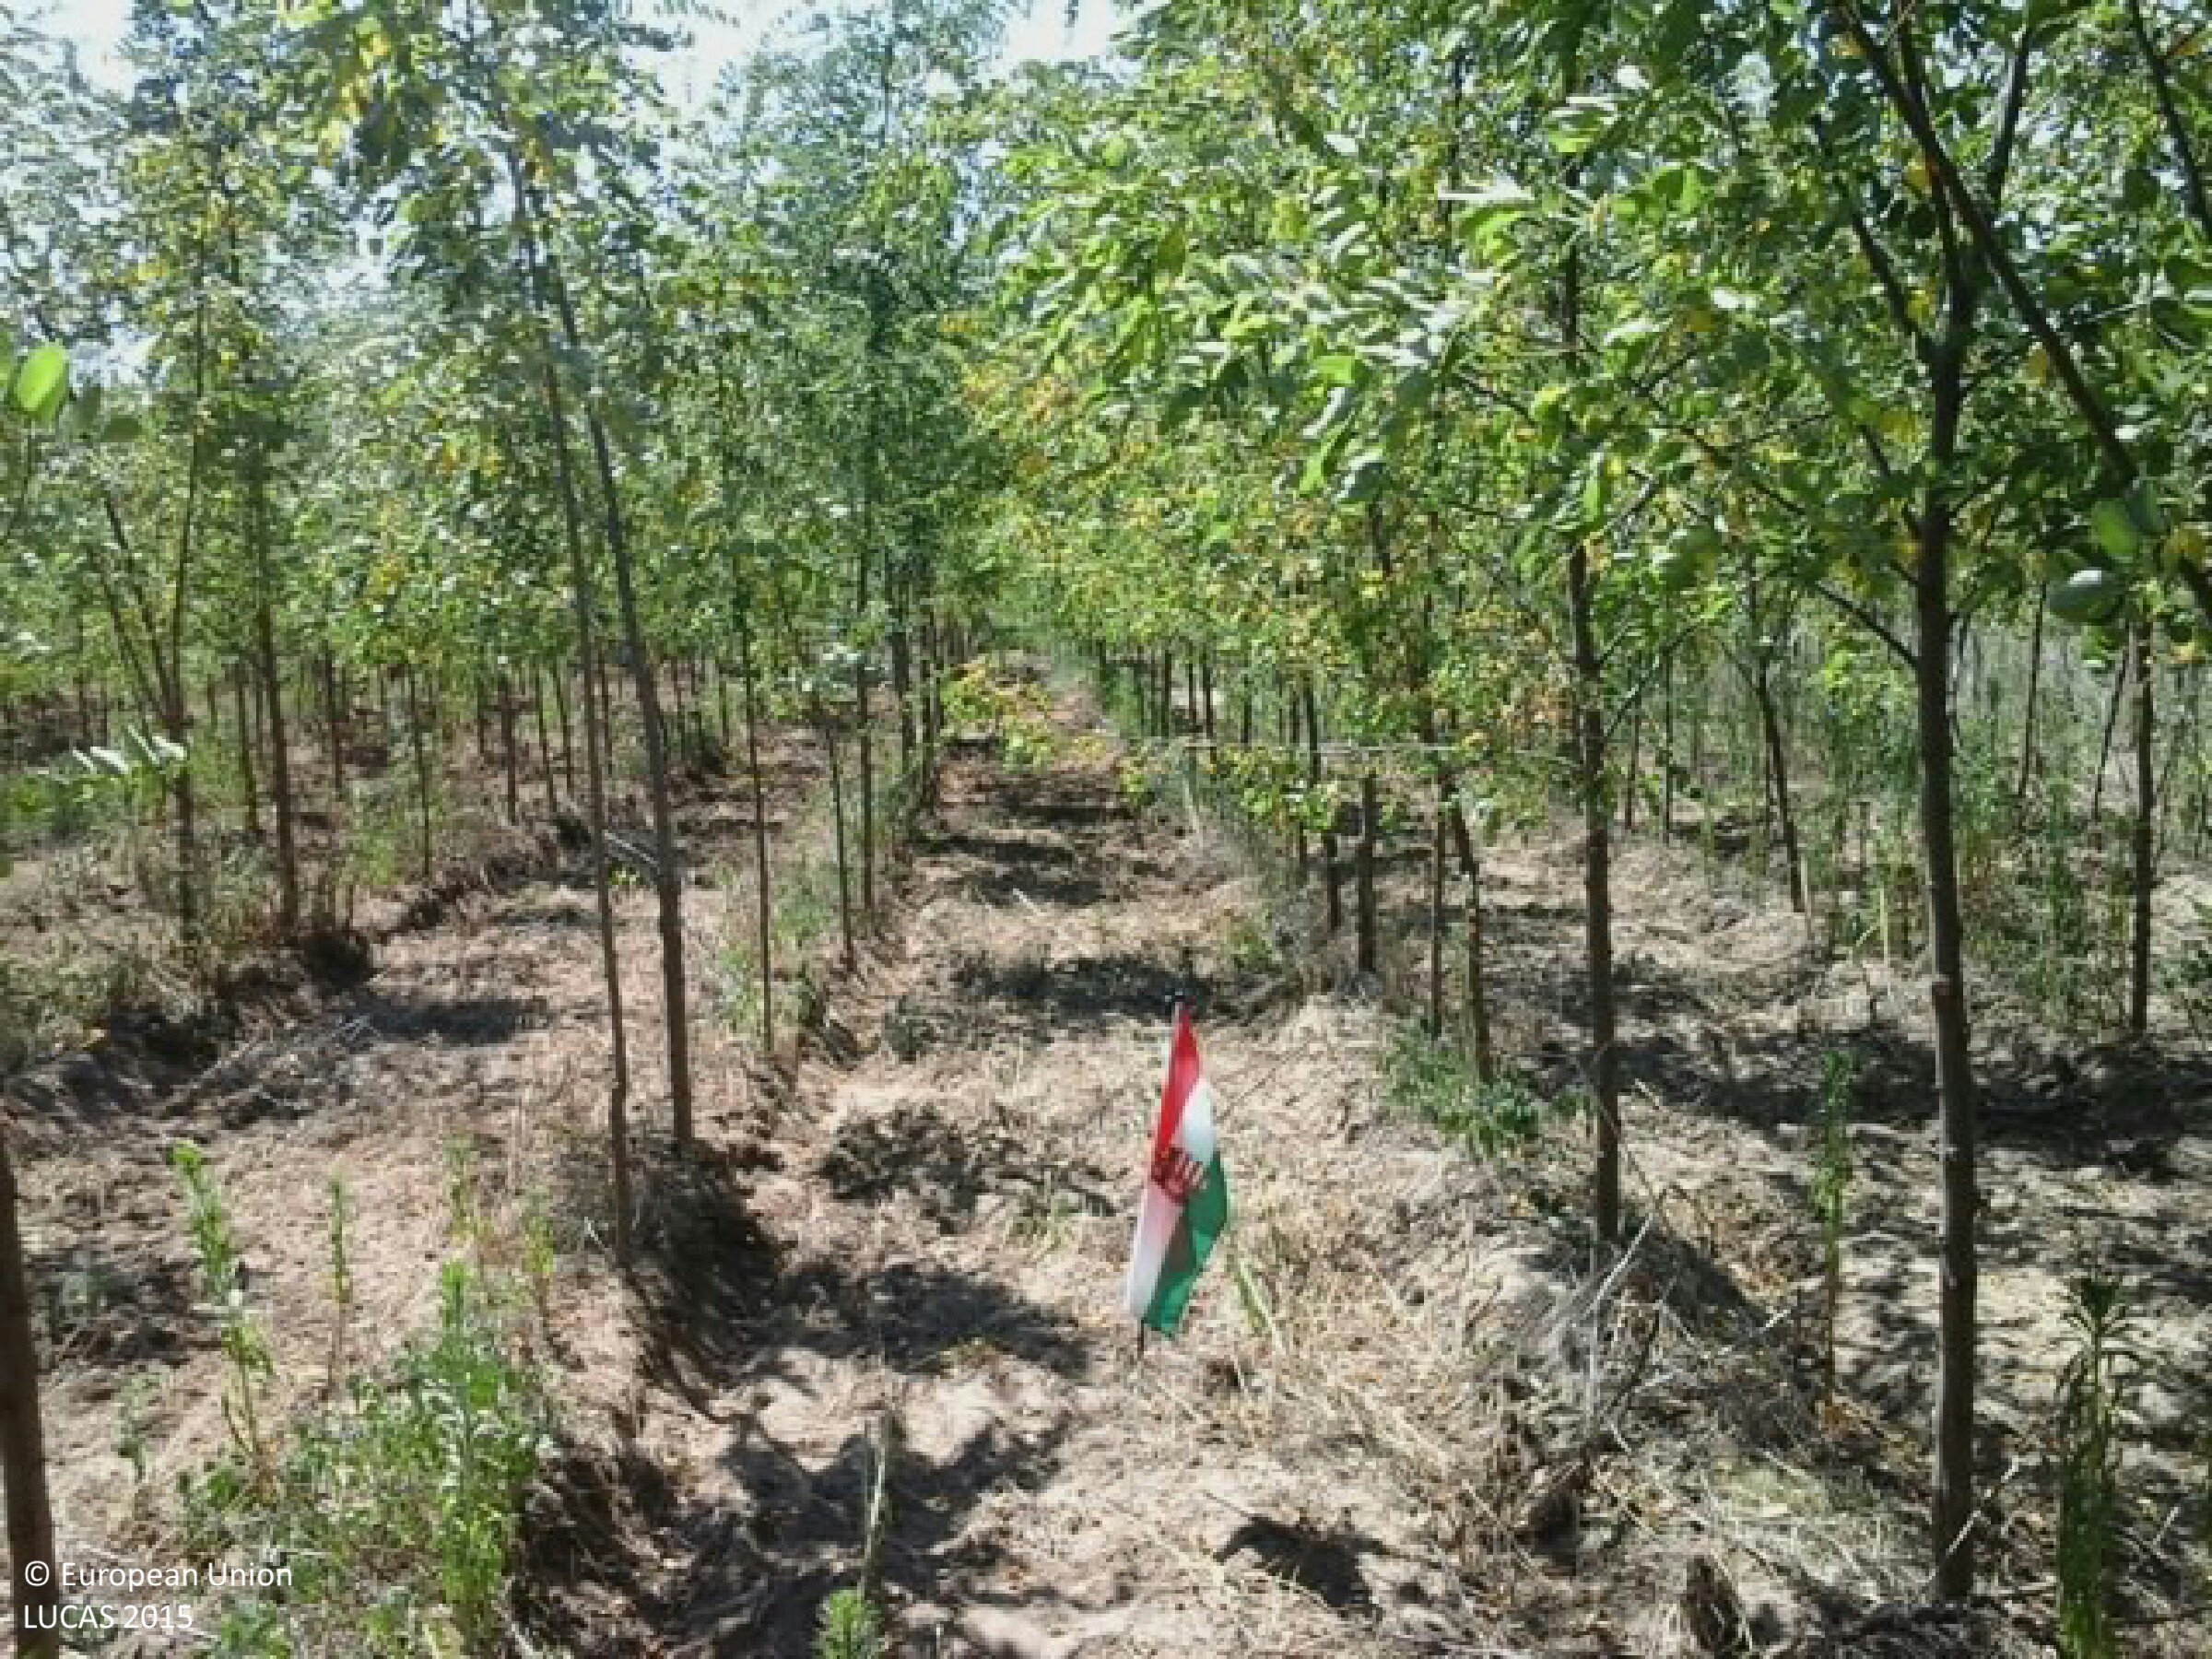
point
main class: Woodland
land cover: Broadleaved woodland
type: exotic forest
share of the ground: 50 - 75 %
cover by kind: broadleaved forest trees 70 %, herbaceous plants 15 %, unconsolidated bare surface 15 %
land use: Forestry
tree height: < 5 m
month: July
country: HU
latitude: 47.2896
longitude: 19.2613
